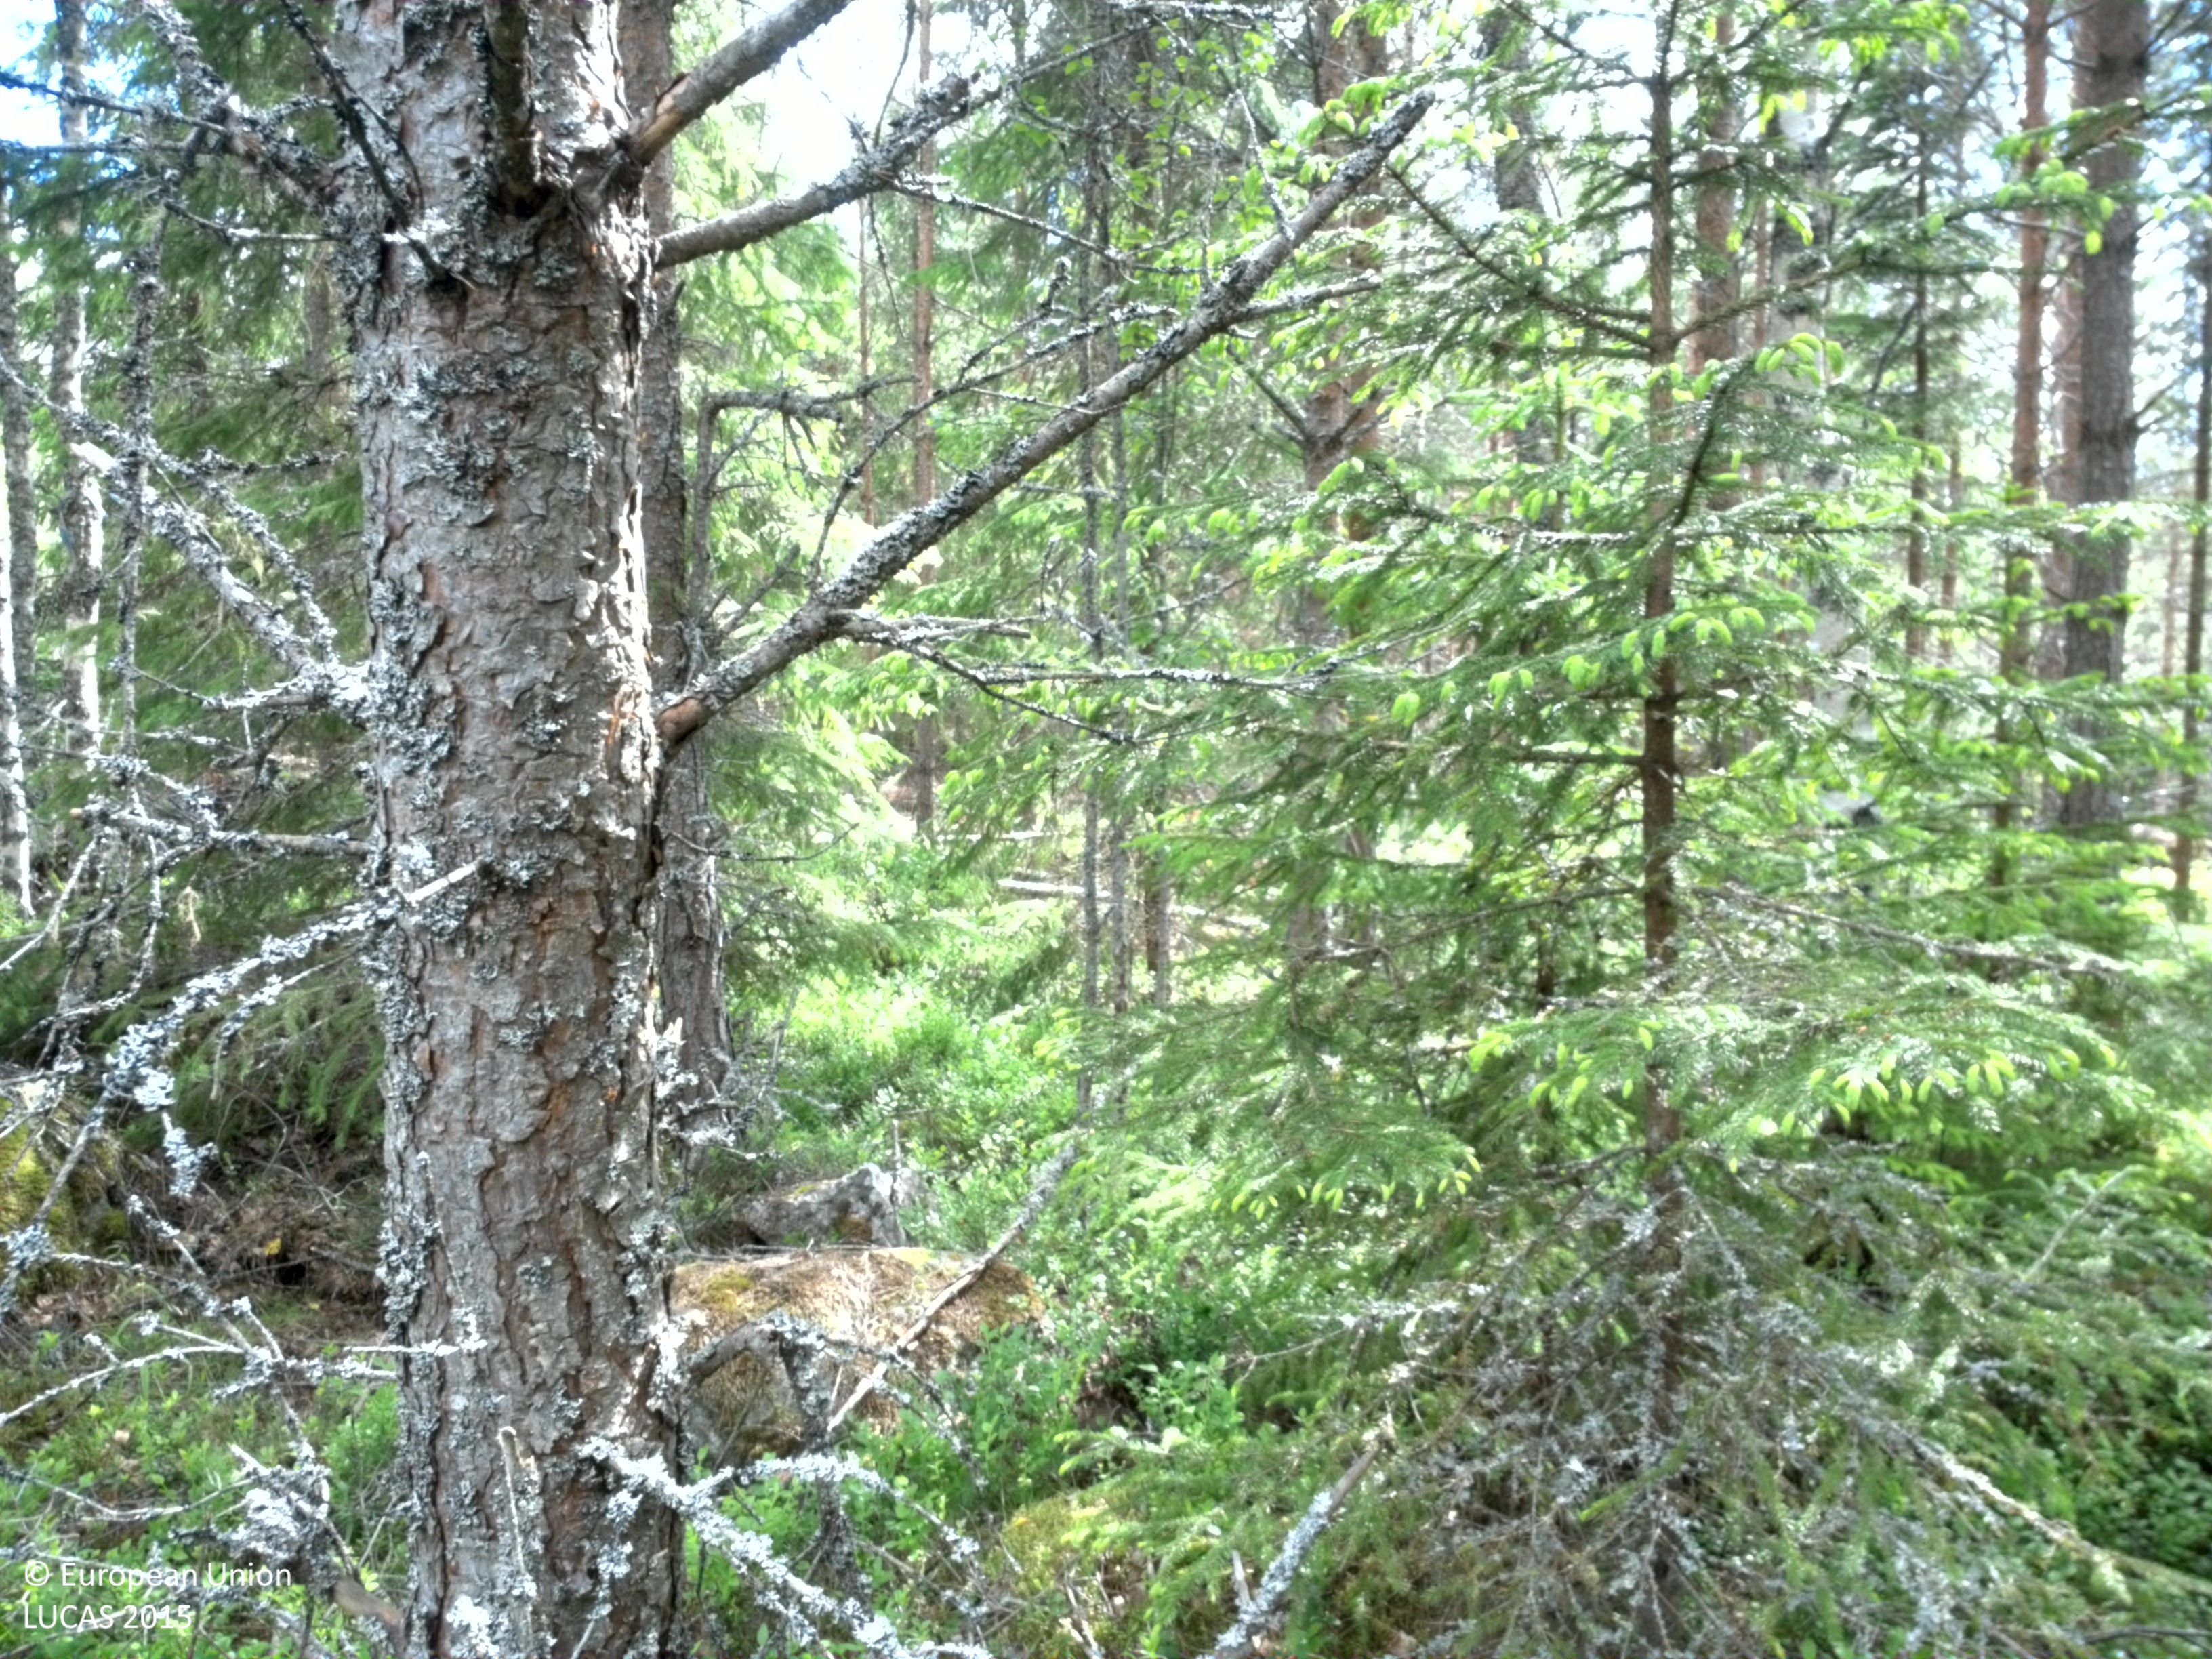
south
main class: Woodland
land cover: Pine dominated mixed woodland
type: boreal forest
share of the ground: 50 - 75 %
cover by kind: coniferous forest trees 40 %, herbaceous plants 35 %, broadleaved forest trees 15 %, lichens and mosses 10 %
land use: Forestry
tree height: > 5 m
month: June
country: SE
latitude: 58.6056
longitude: 15.6564
